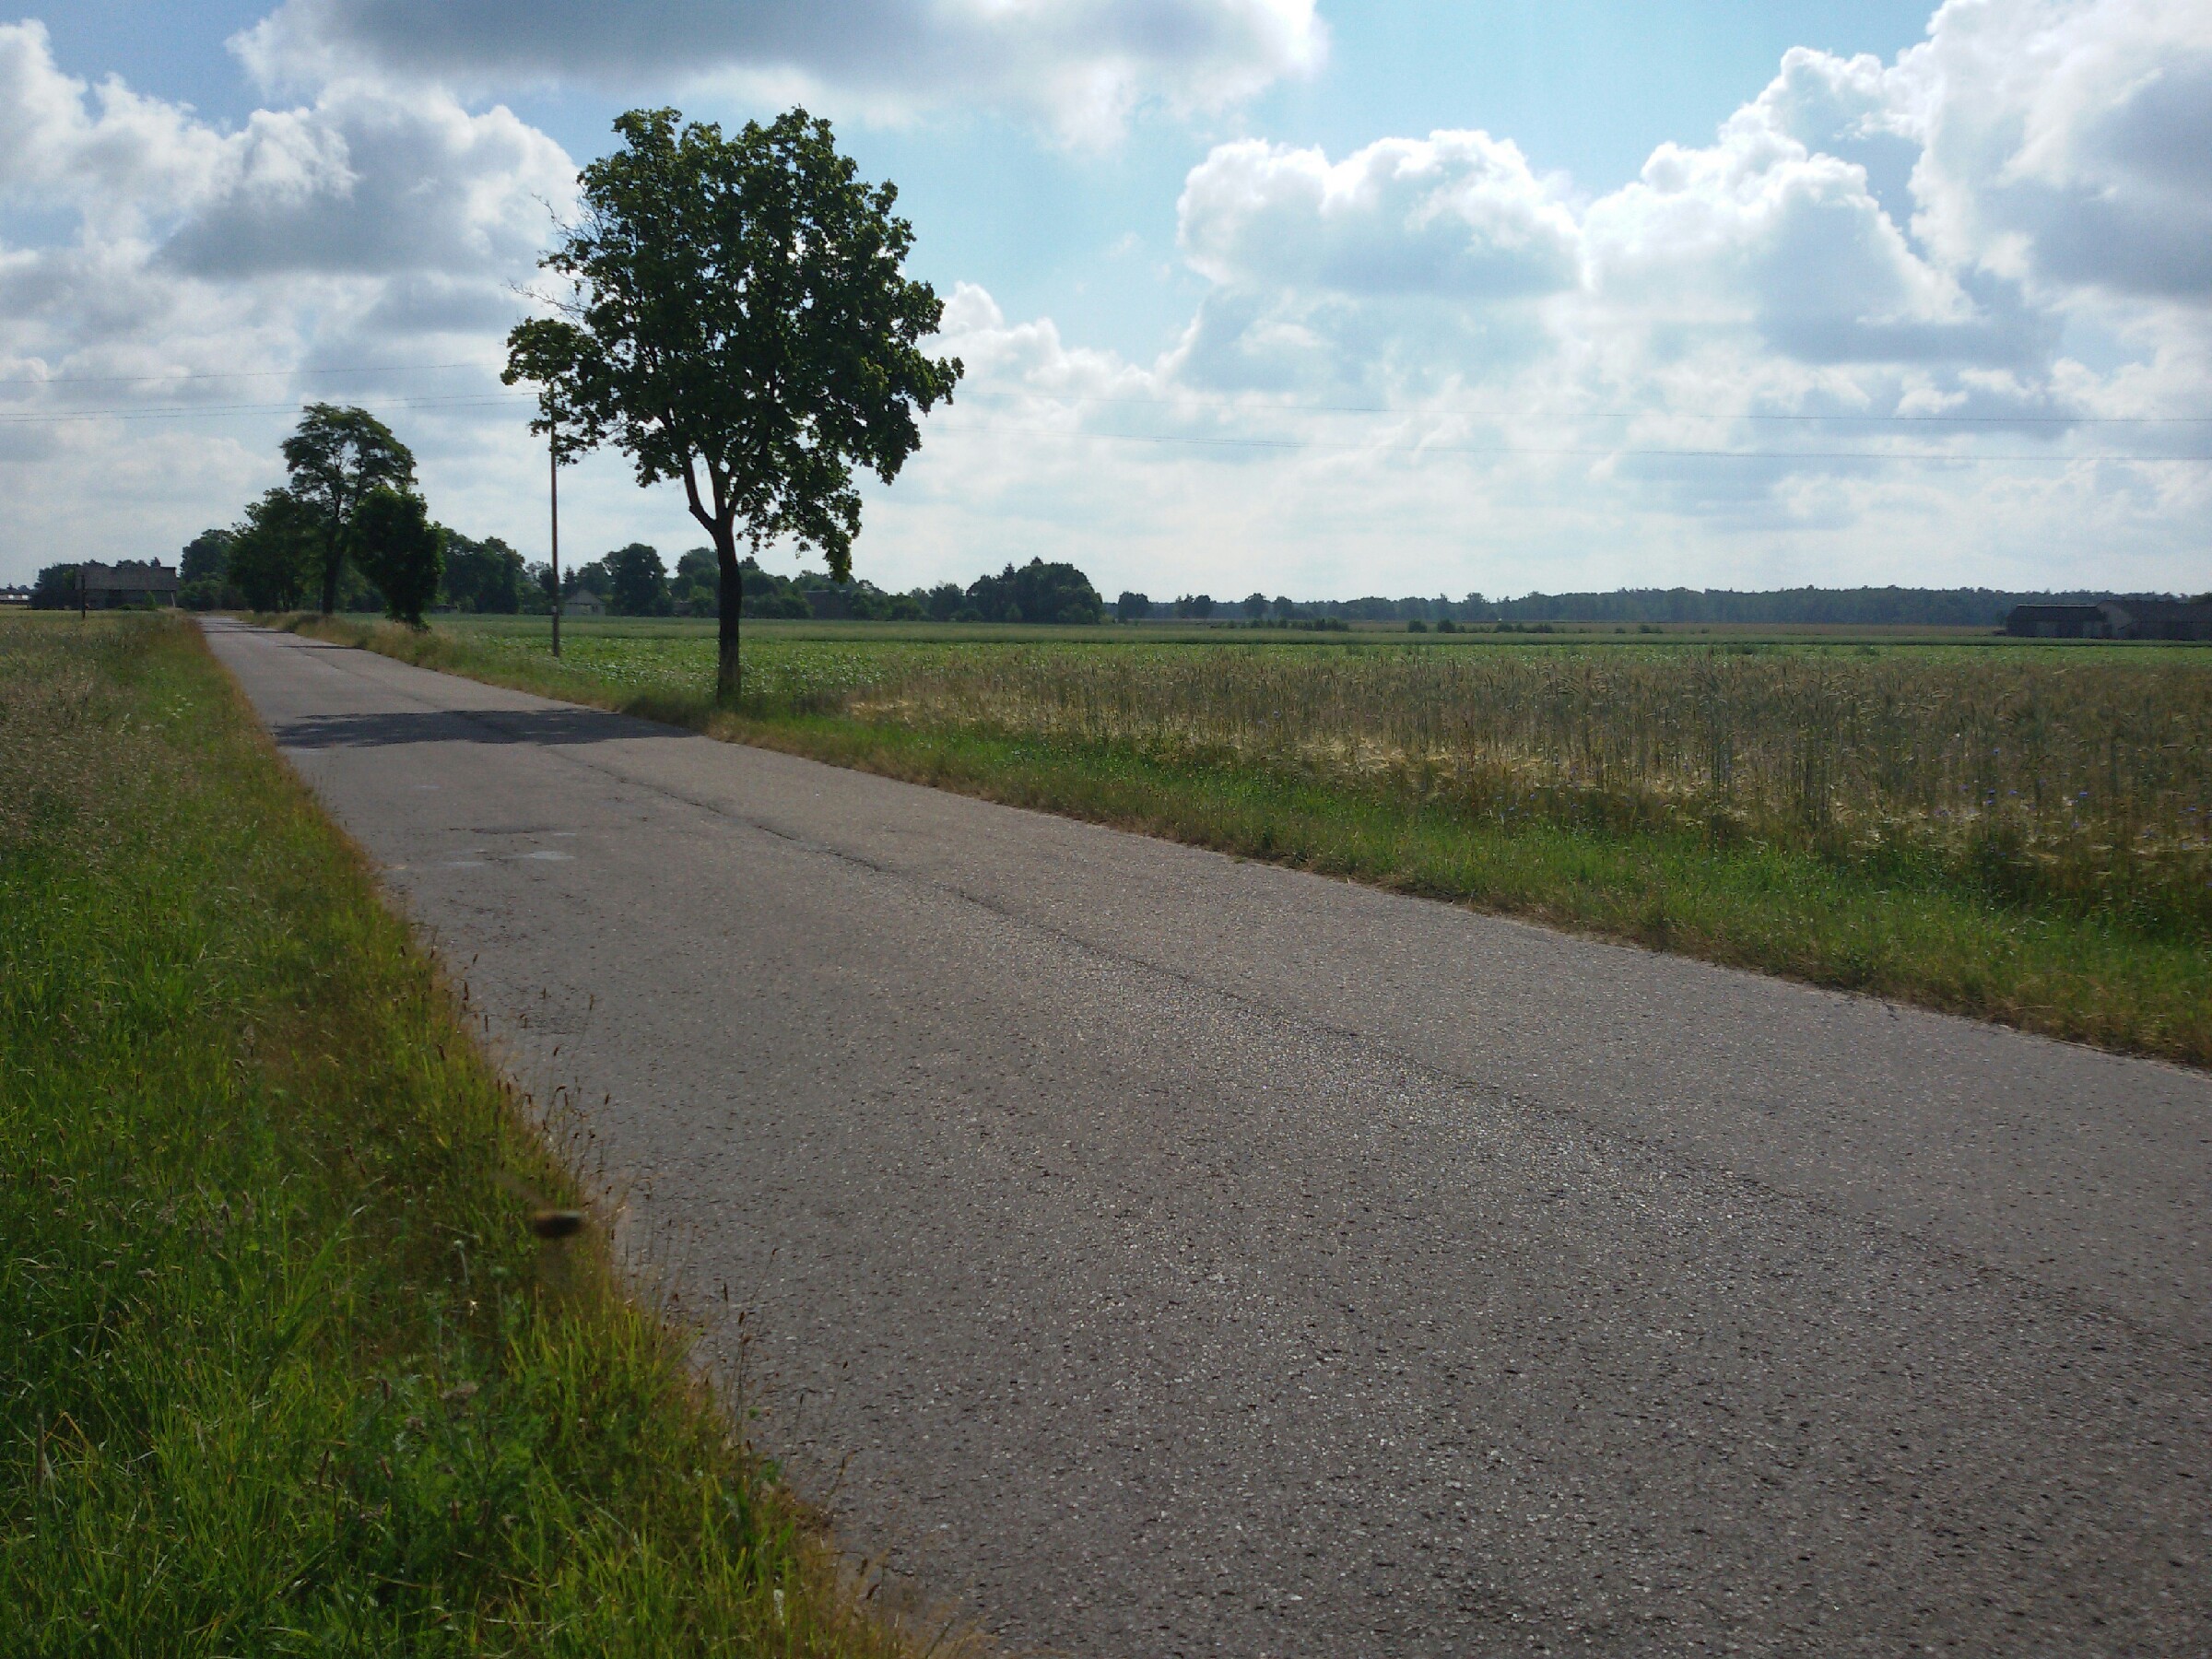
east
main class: Cropland
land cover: Rye
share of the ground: > 75 %
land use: Agriculture (excluding fallow land and kitchen gardens)
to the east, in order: Rye; Triticale; Rye; Potatoes; Oats; Electric lines; Oats; Triticale
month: June
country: PL
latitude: 51.9219
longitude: 23.0905
